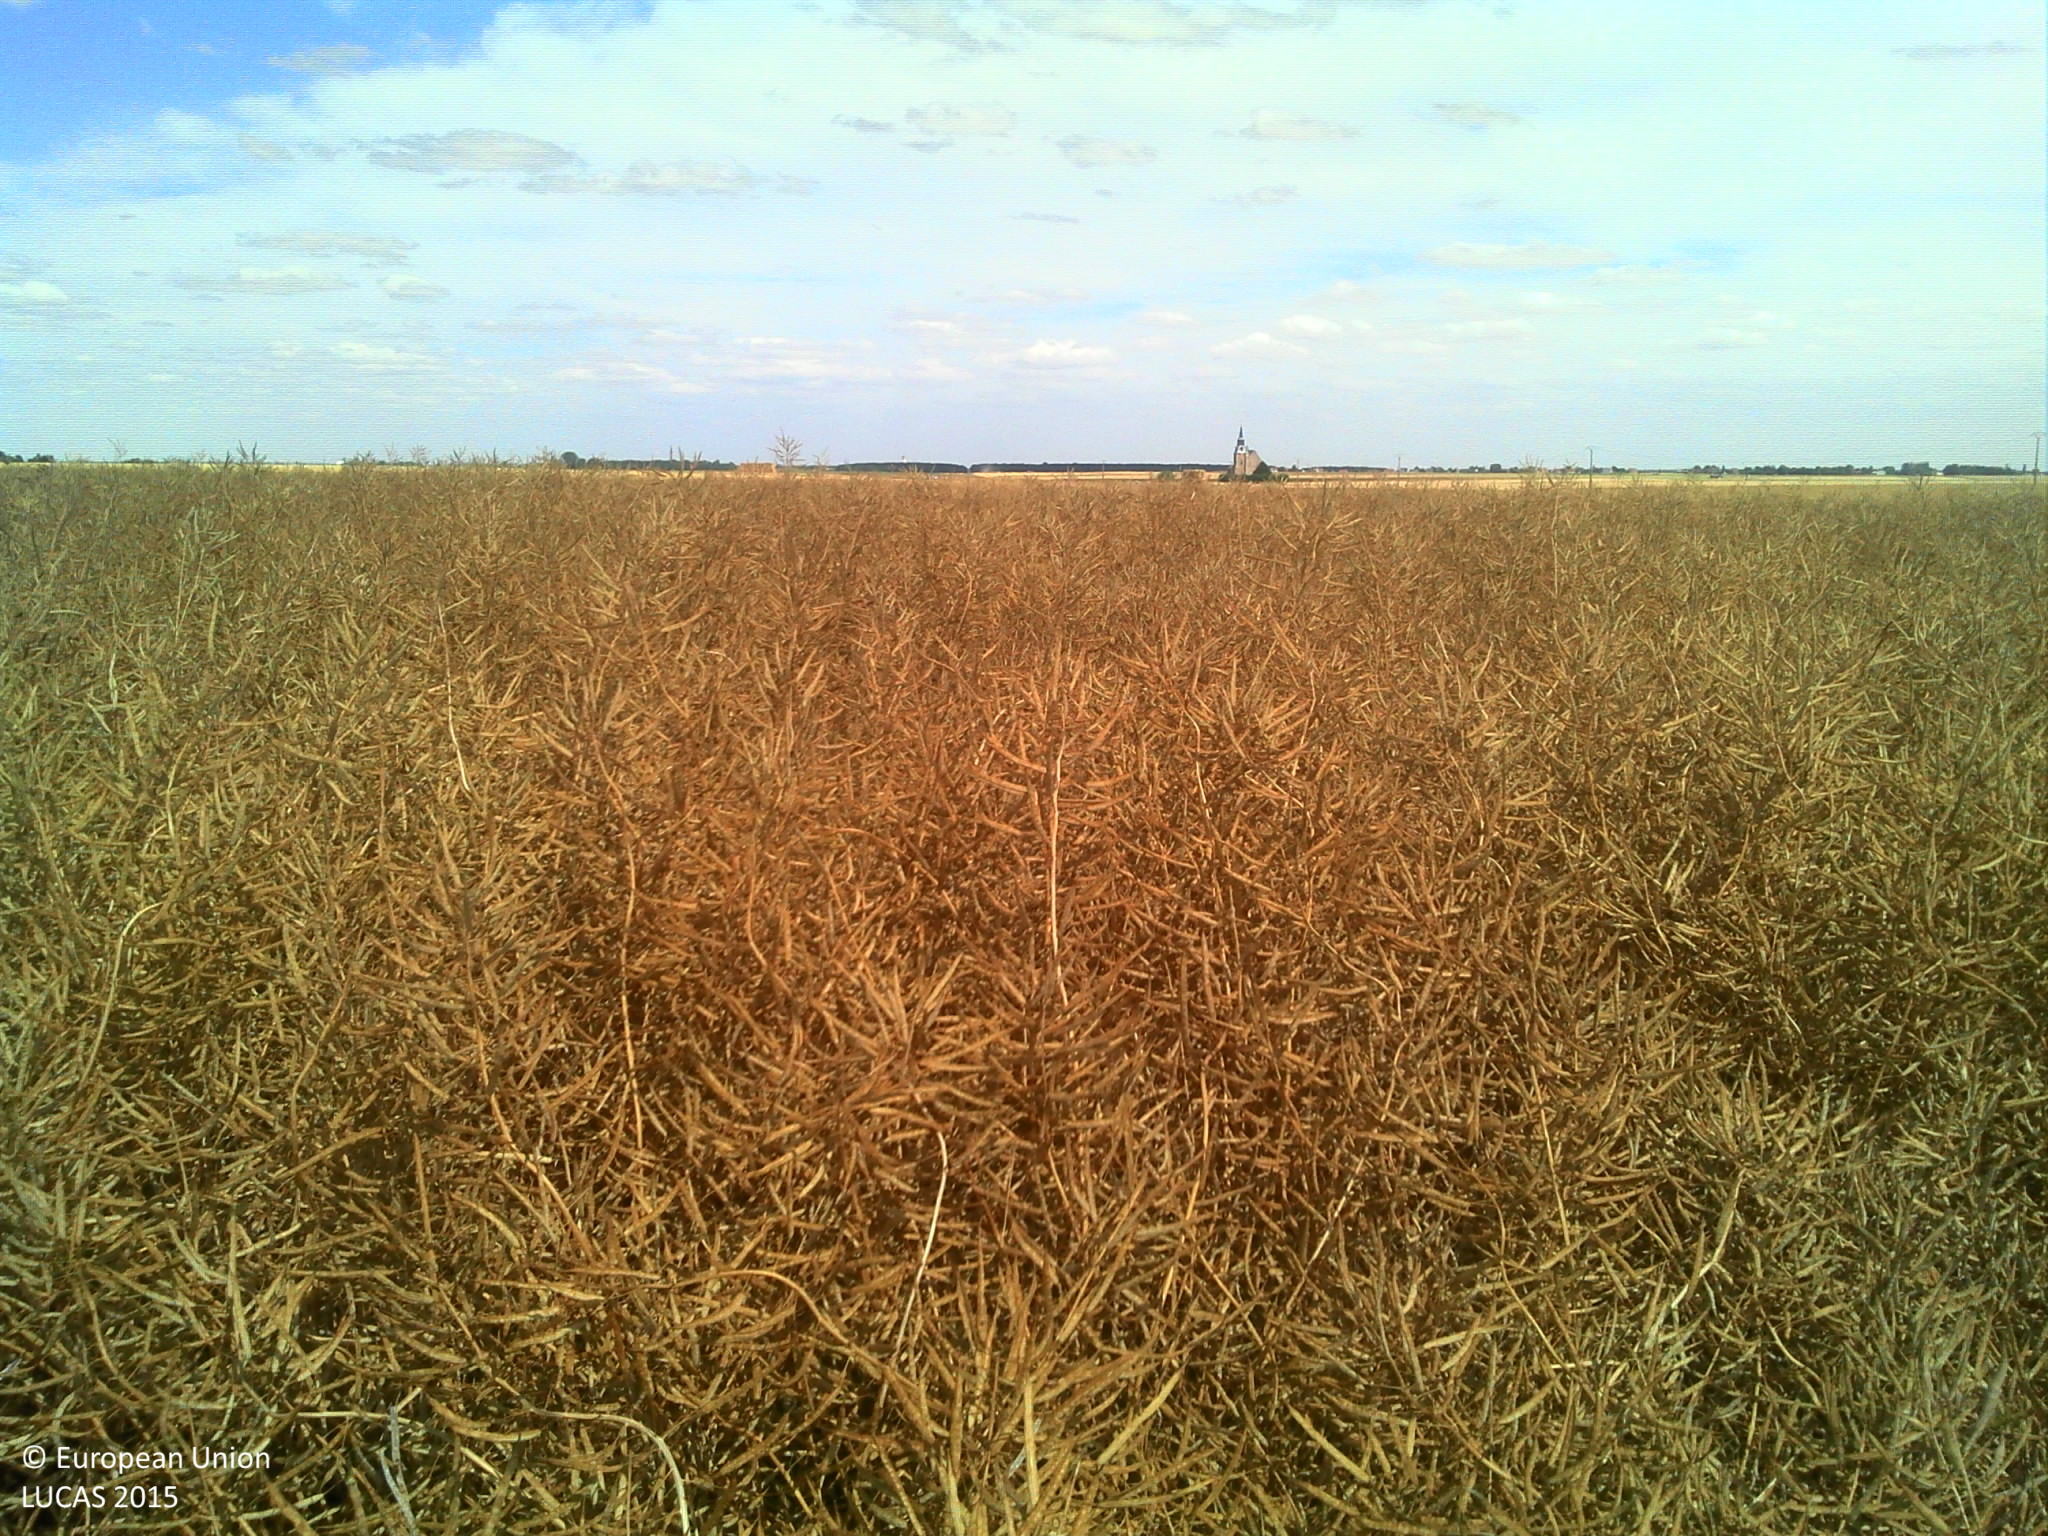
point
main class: Cropland
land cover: Rape and turnip rape
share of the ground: > 75 %
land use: Agriculture (excluding fallow land and kitchen gardens)
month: July
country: FR
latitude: 48.4015
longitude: 1.2694
